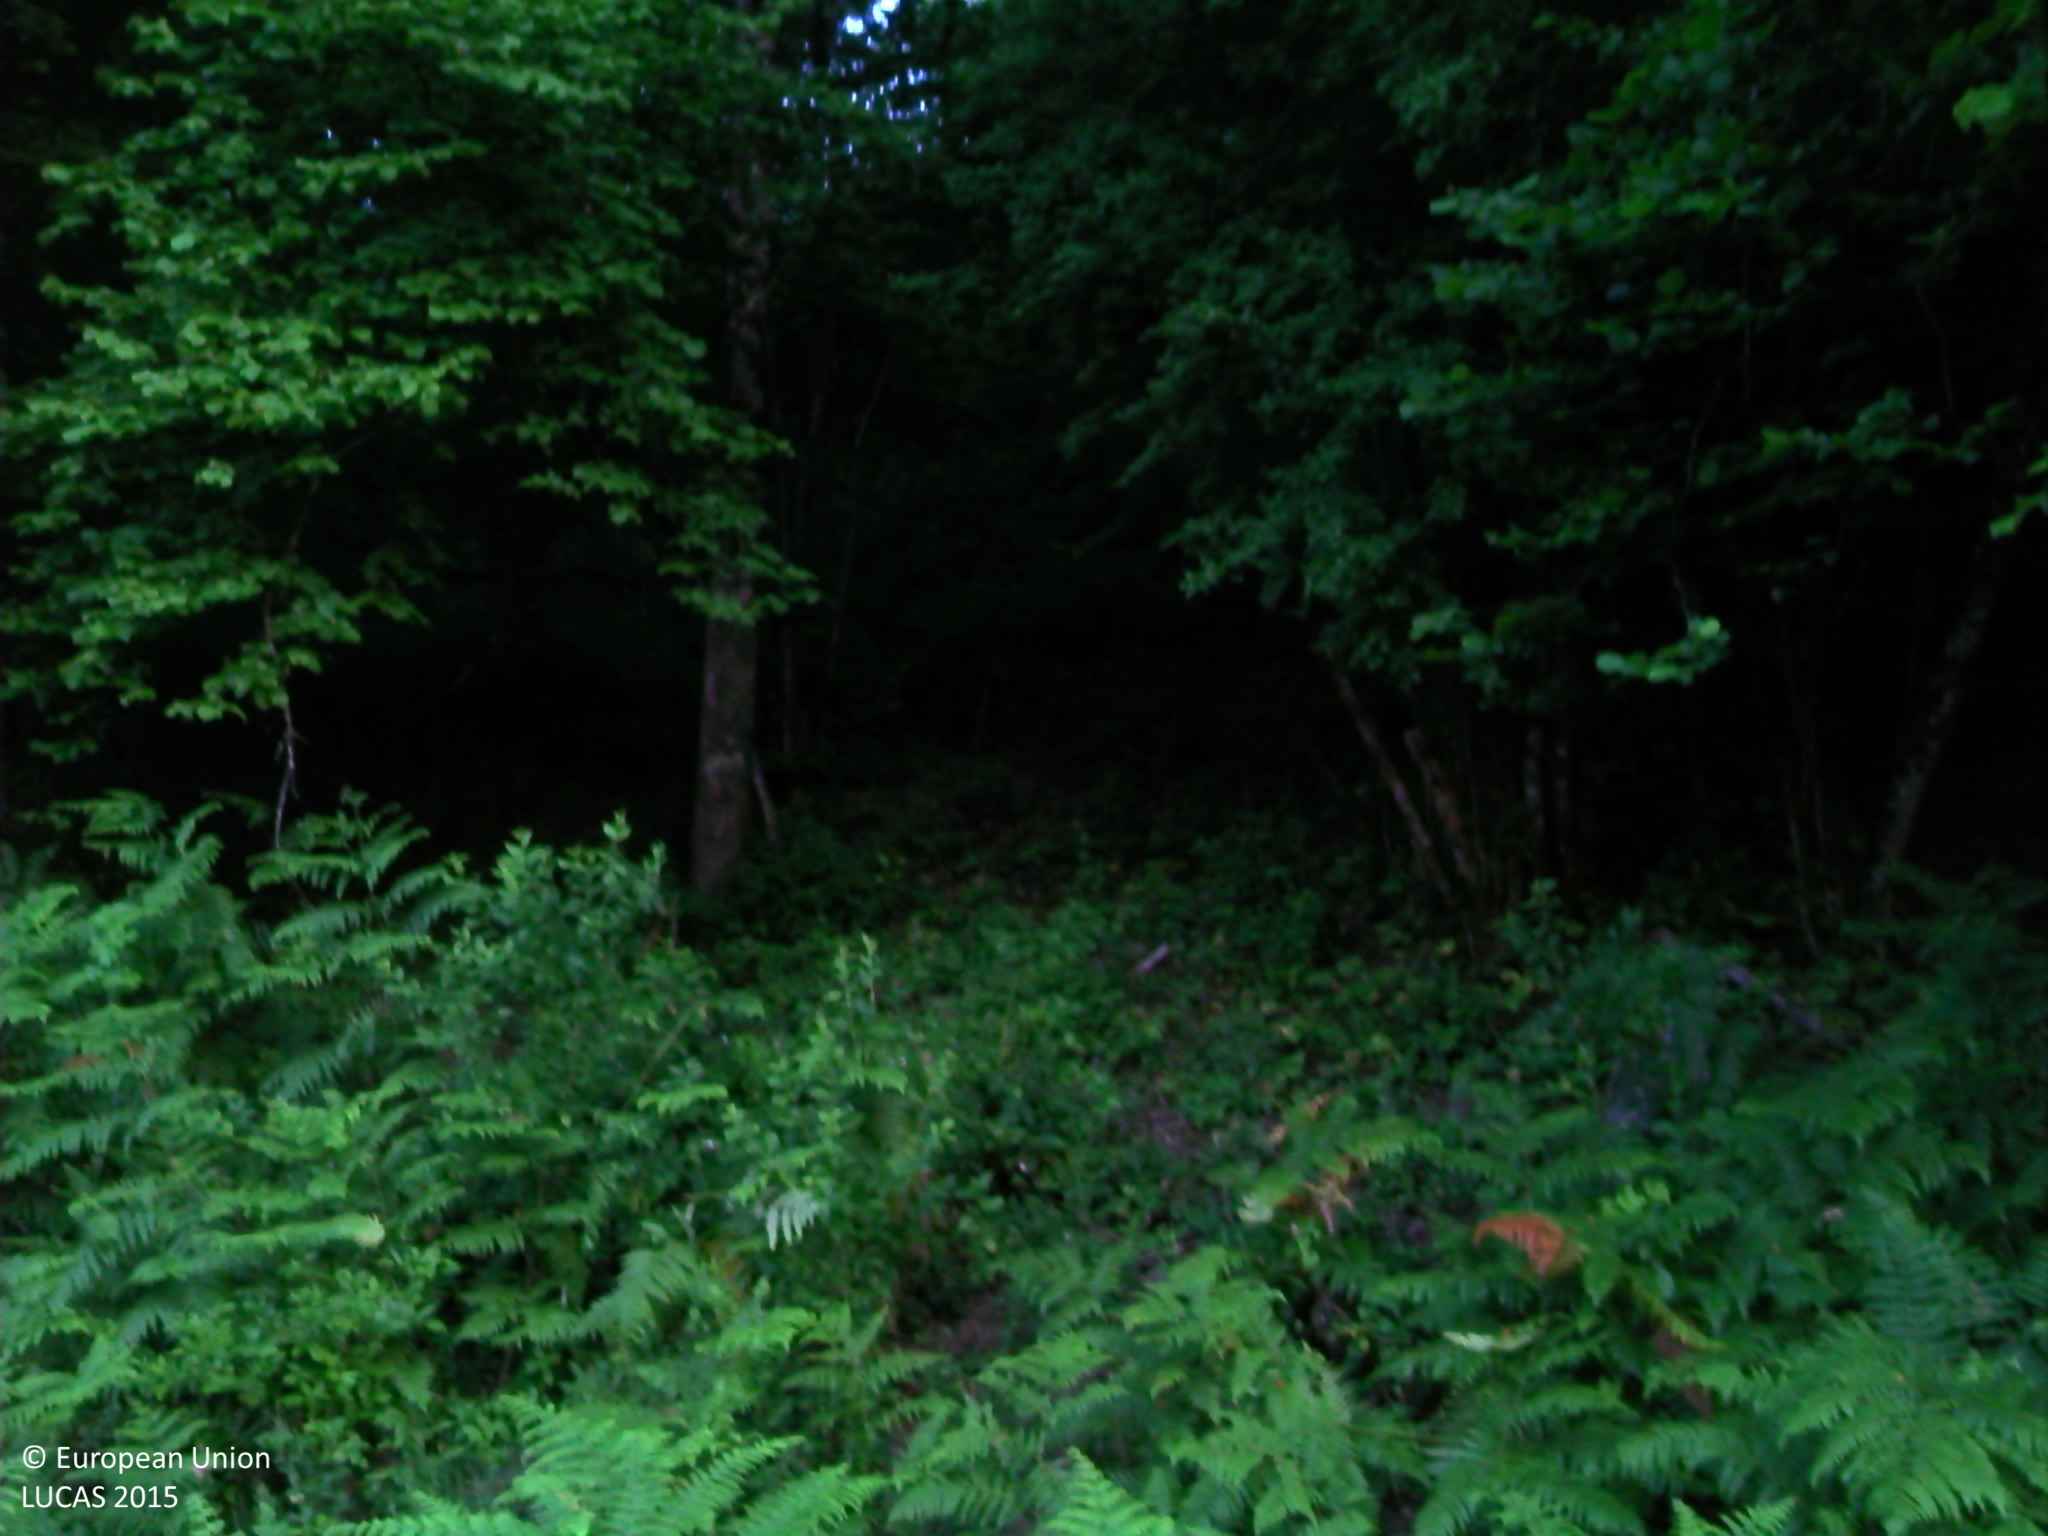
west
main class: Shrubland
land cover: Shrubland without tree cover
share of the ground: > 75 %
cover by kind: shrubs 70 %, herbaceous plants 30 %
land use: Agriculture (excluding fallow land and kitchen gardens)
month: June
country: FR
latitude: 45.3250
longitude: 2.4589
